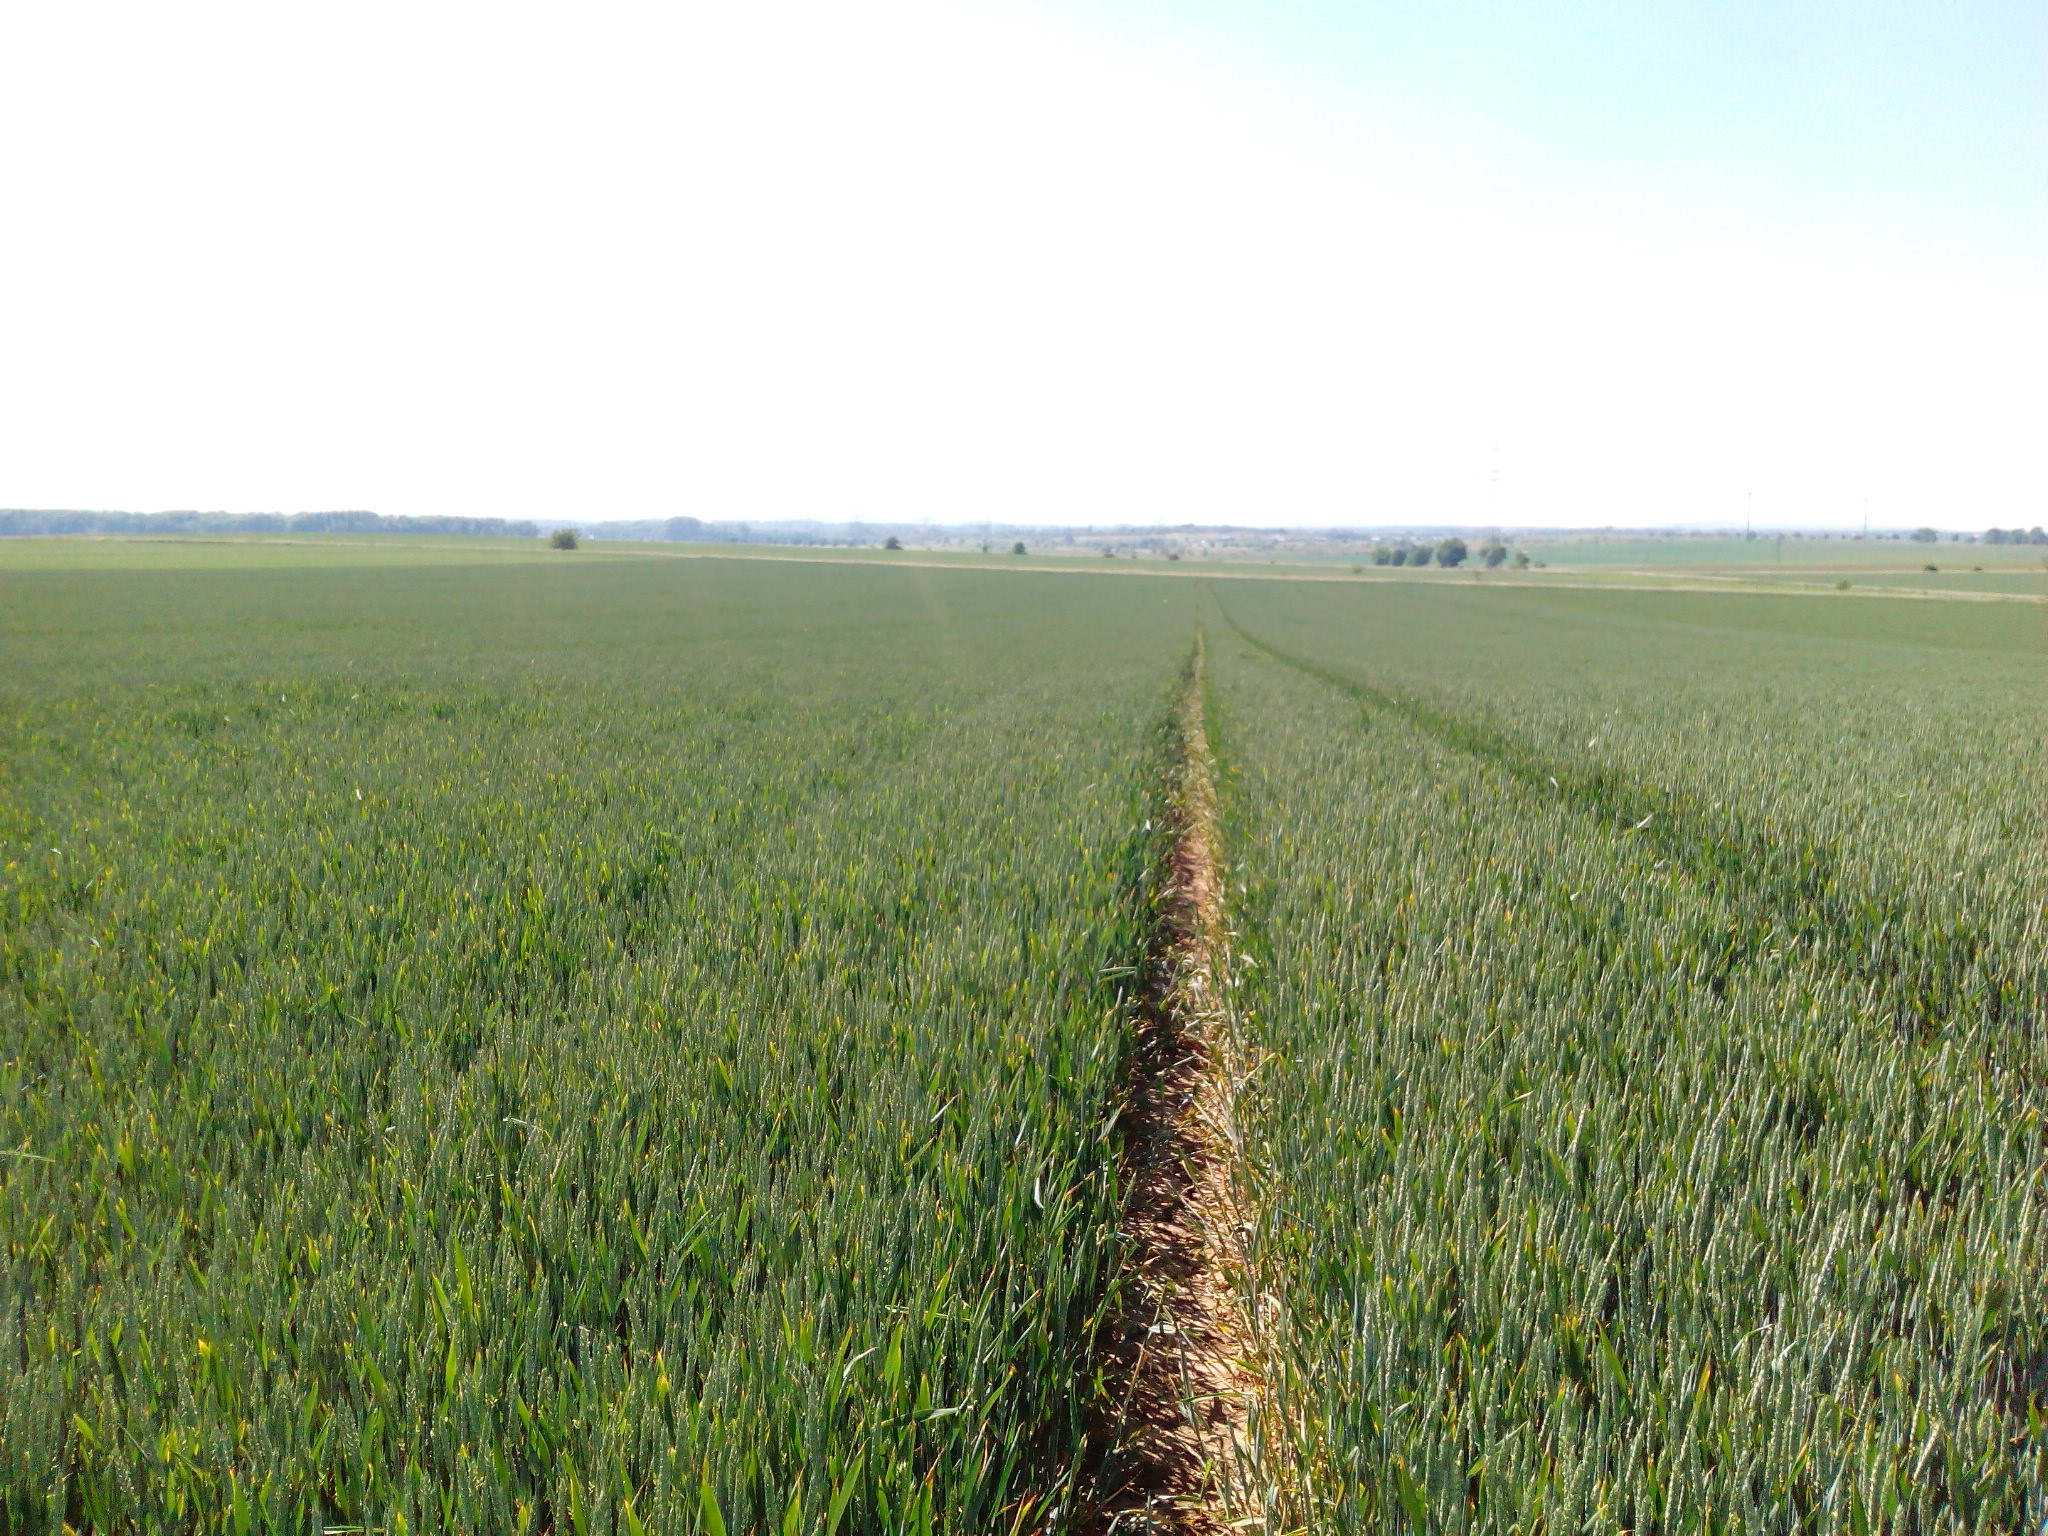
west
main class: Cropland
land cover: Common wheat
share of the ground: > 75 %
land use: Agriculture (excluding fallow land and kitchen gardens)
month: June
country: DE
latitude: 52.2696
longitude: 9.8975
